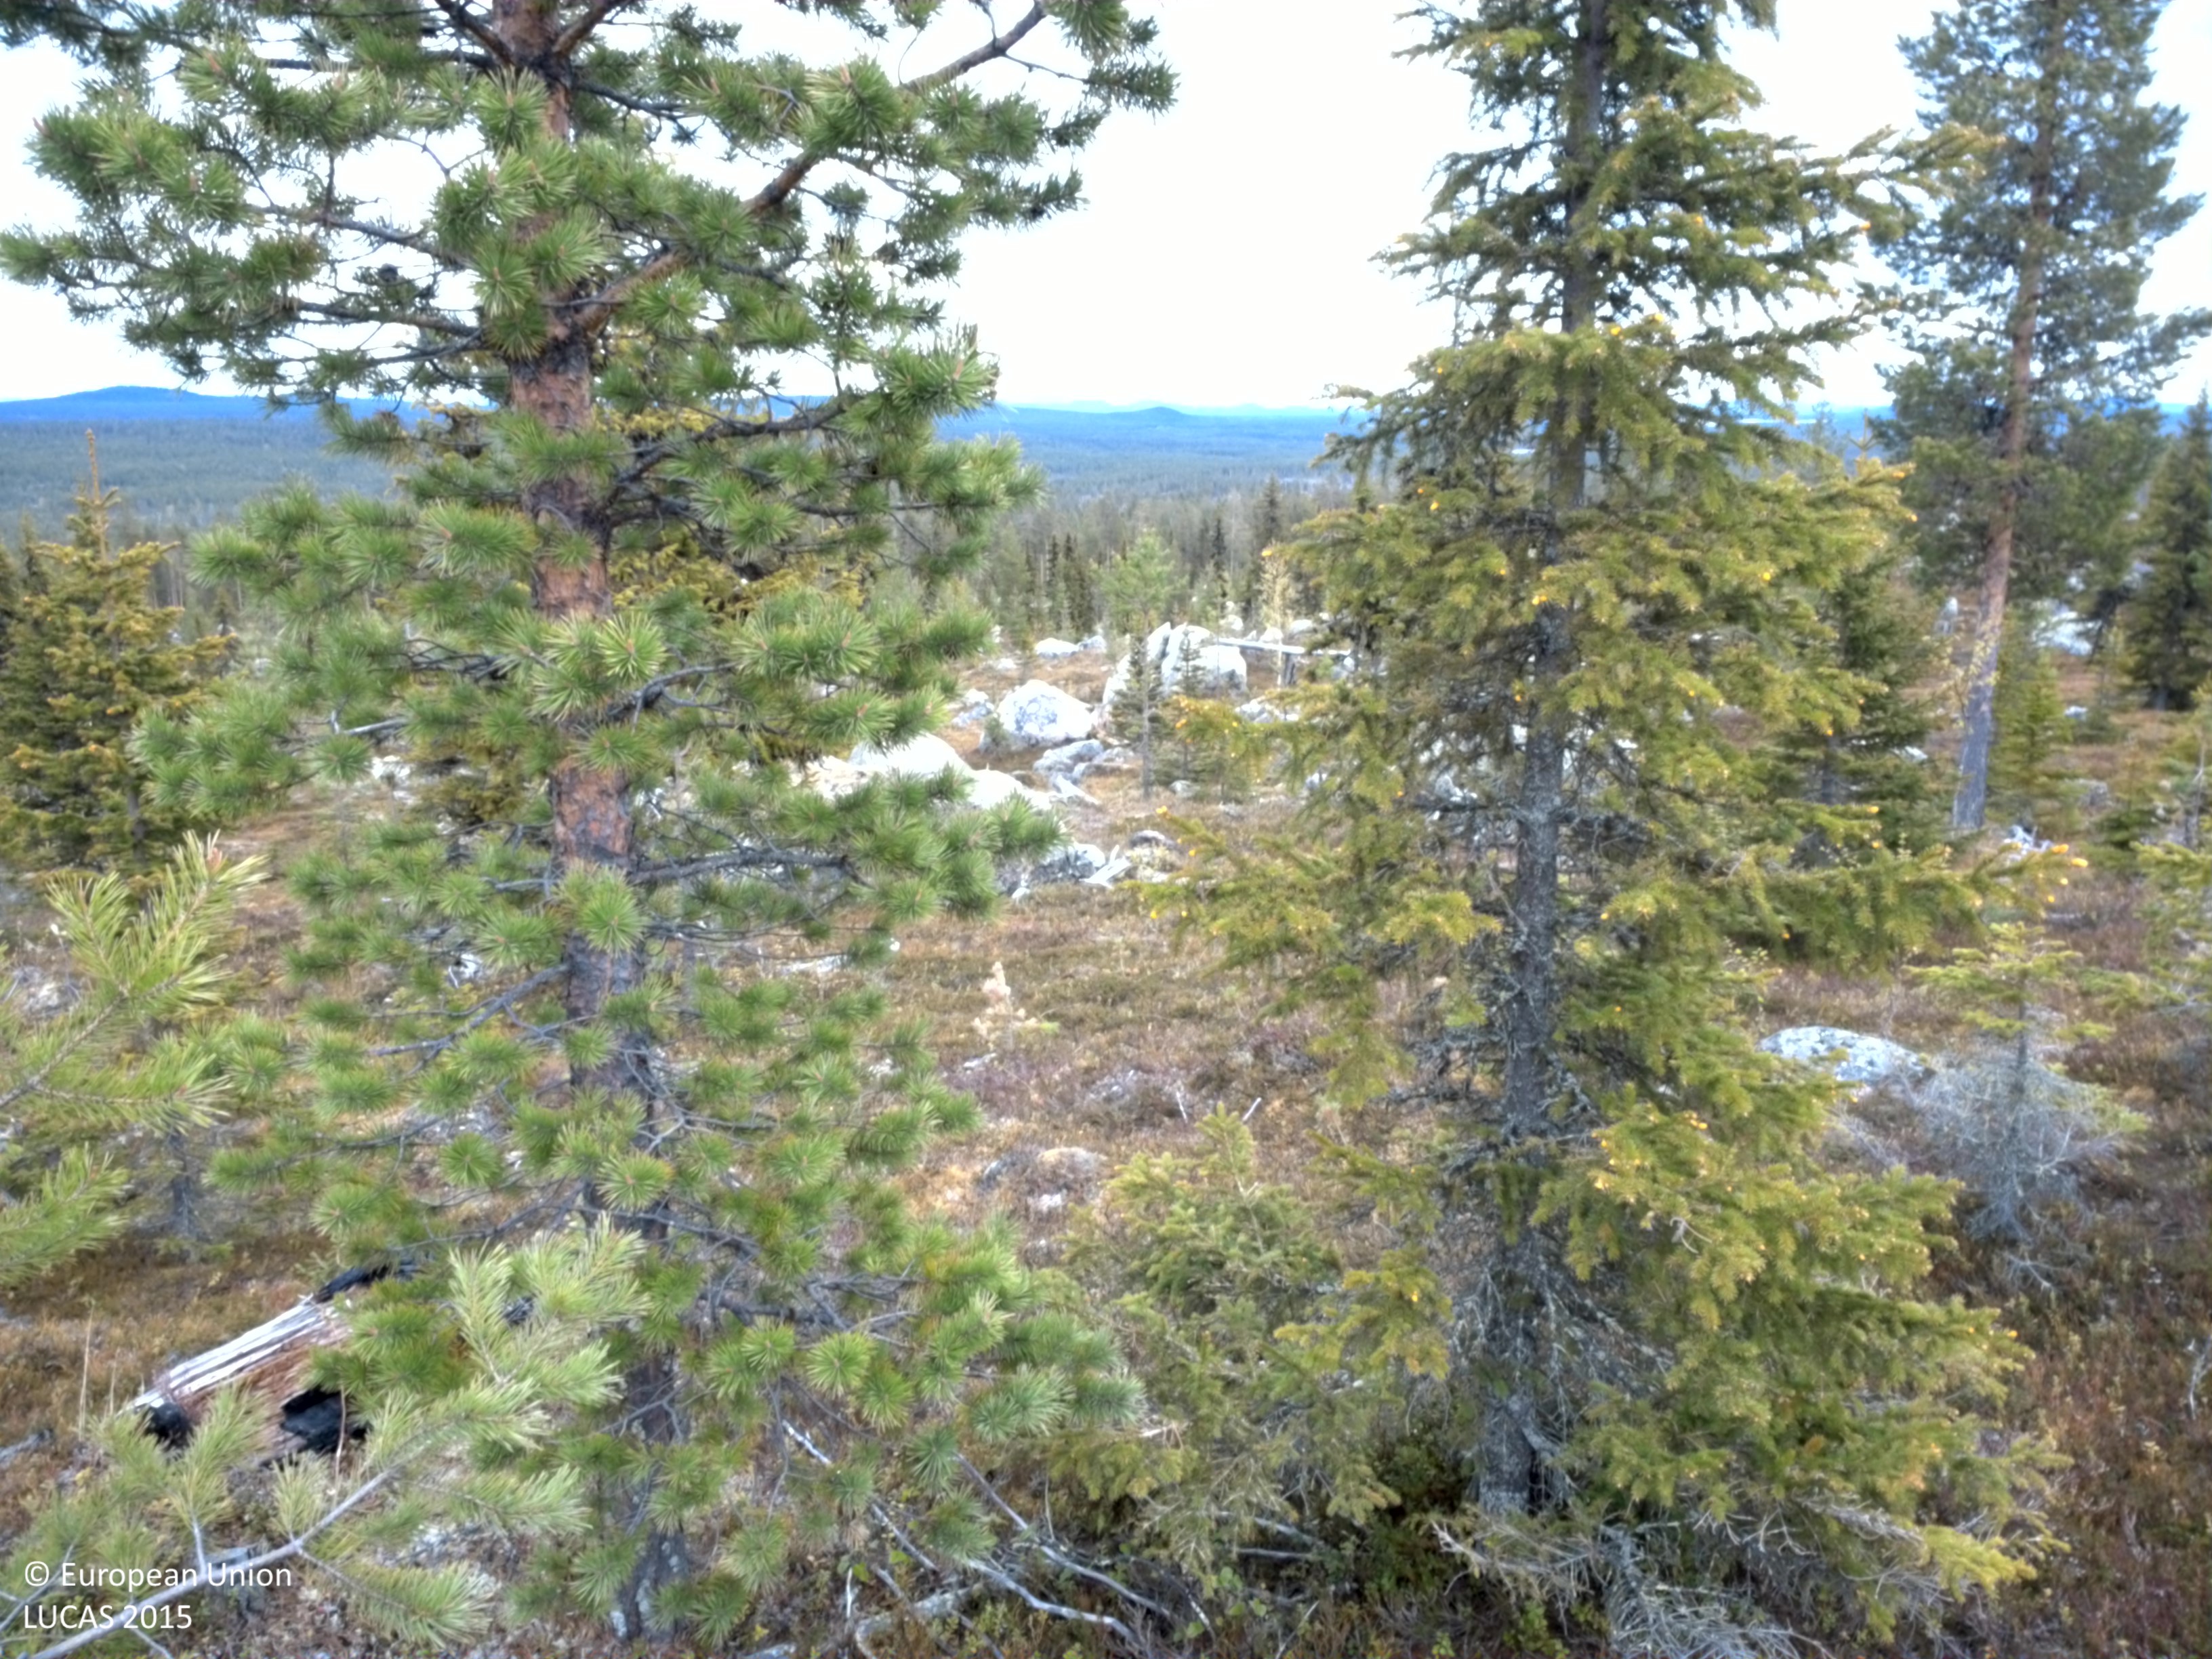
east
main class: Woodland
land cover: Spruce dominated mixed woodland
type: boreal forest
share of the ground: 10 - 25 %
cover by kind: shrubs 65 %, coniferous forest trees 15 %, consolidated bare surface 10 %, broadleaved forest trees 5 %, lichens and mosses 5 %
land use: Forestry
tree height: < 5 m
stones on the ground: > 50 %
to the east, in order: Spruce dominated mixed woodland; Pine dominated coniferous woodland; Pine dominated mixed woodland; Pine dominated coniferous woodland; Rocks and stones; Pine dominated coniferous woodland
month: June
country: SE
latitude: 66.0555
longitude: 18.6333
